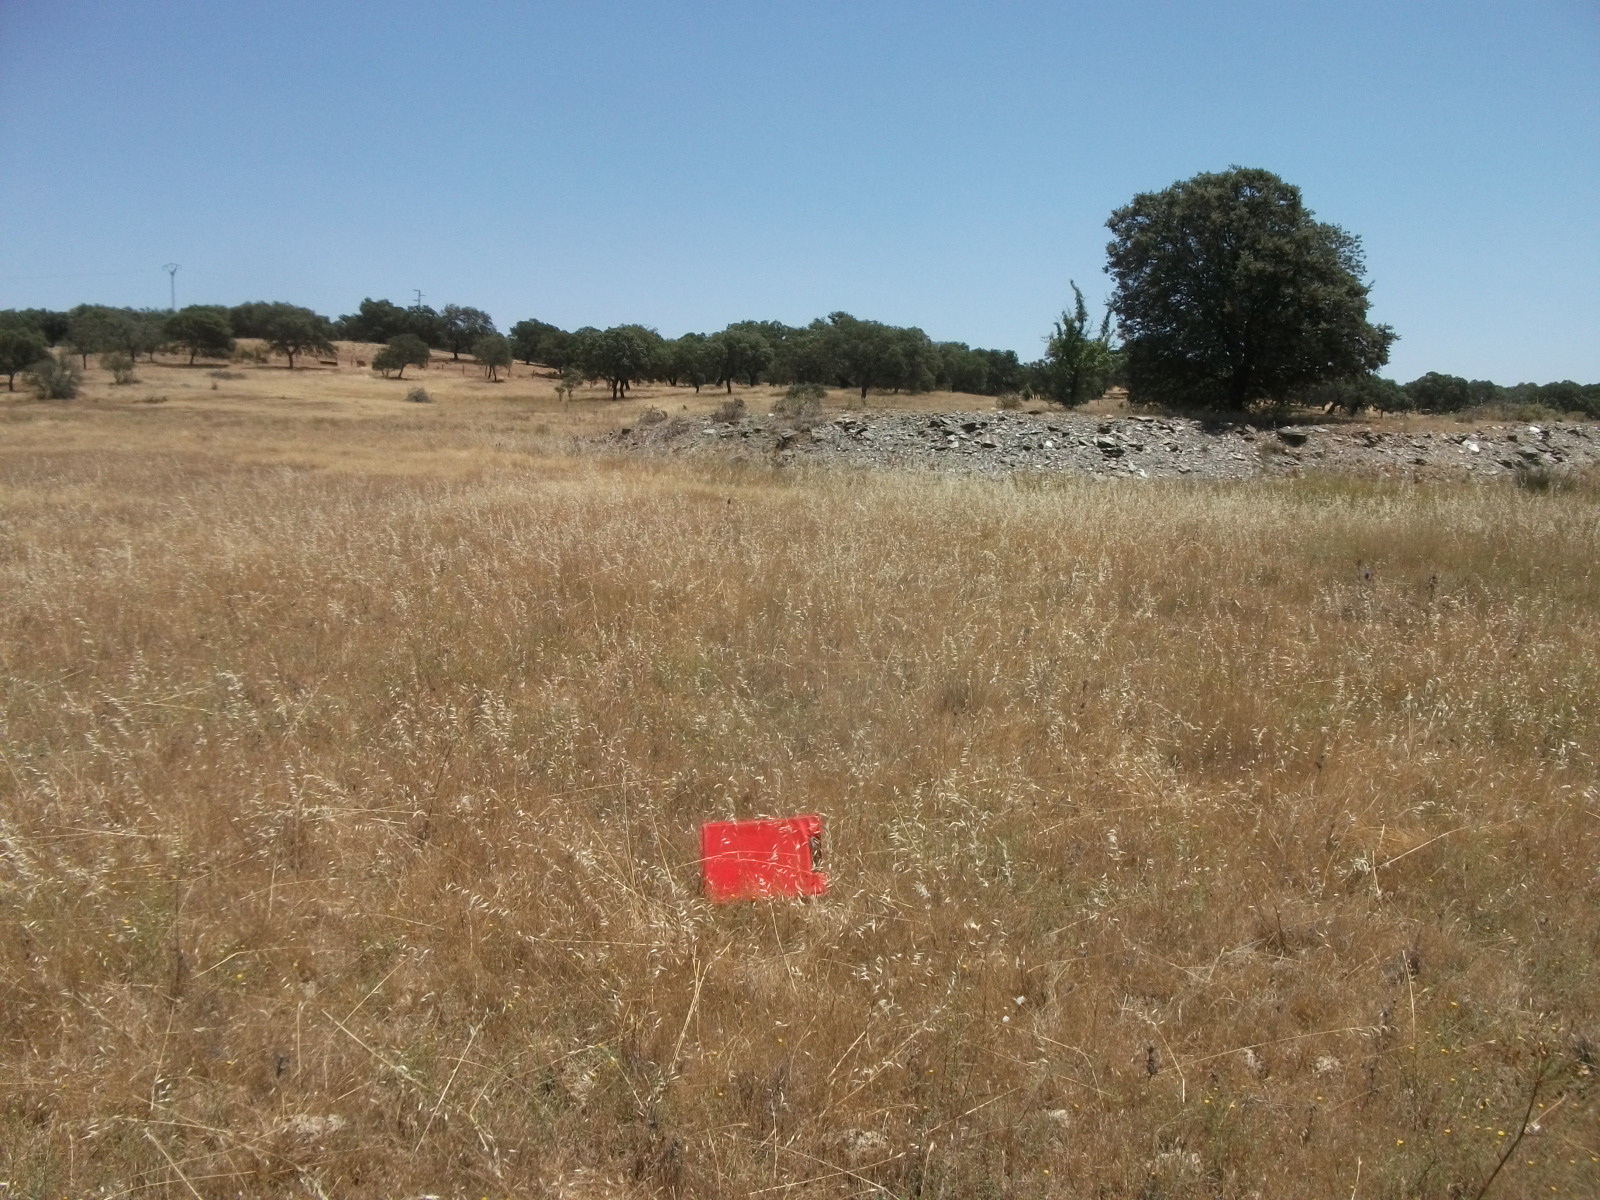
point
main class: Grassland
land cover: Grassland without tree/shrub cover
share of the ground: > 75 %
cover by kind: herbaceous plants 100 %
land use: Agriculture (excluding fallow land and kitchen gardens)
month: June
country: ES
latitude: 37.6625
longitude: -7.1105
